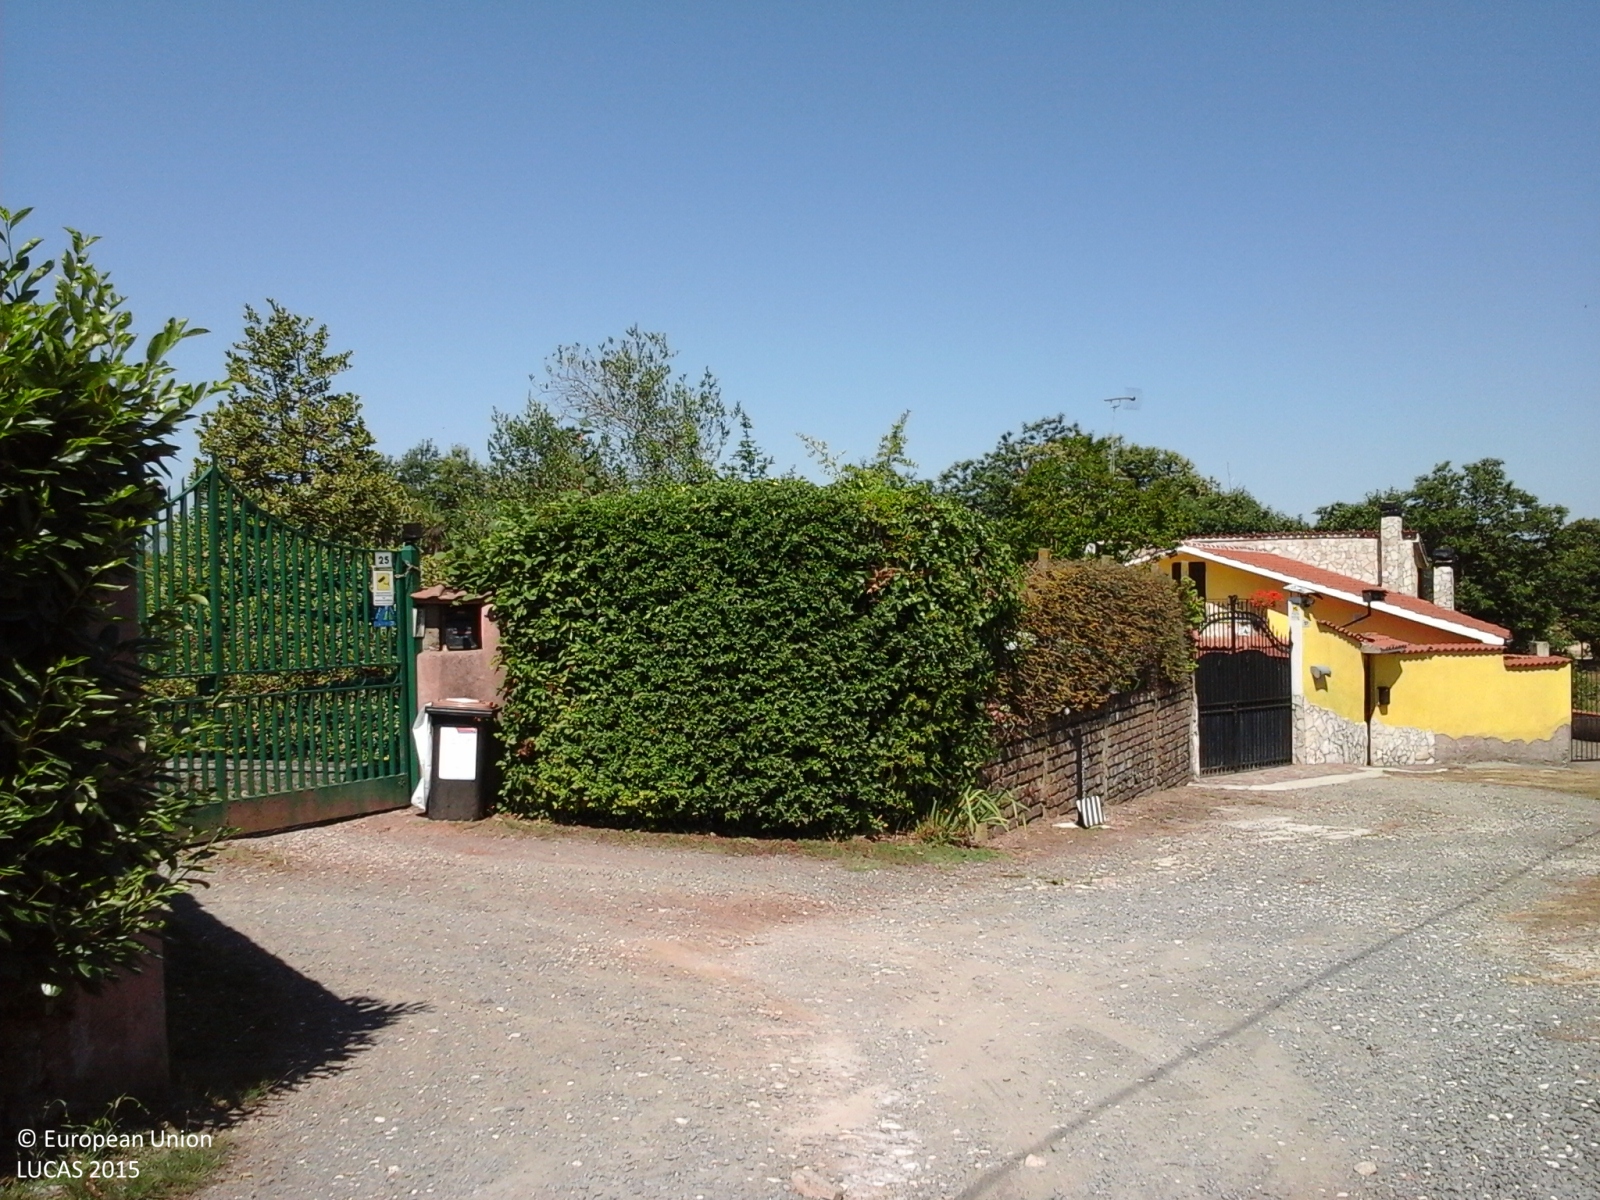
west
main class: Grassland
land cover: Grassland without tree/shrub cover
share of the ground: > 75 %
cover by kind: herbaceous plants 100 %
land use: Agriculture (excluding fallow land and kitchen gardens)
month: July
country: IT
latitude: 41.8188
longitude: 12.8425
